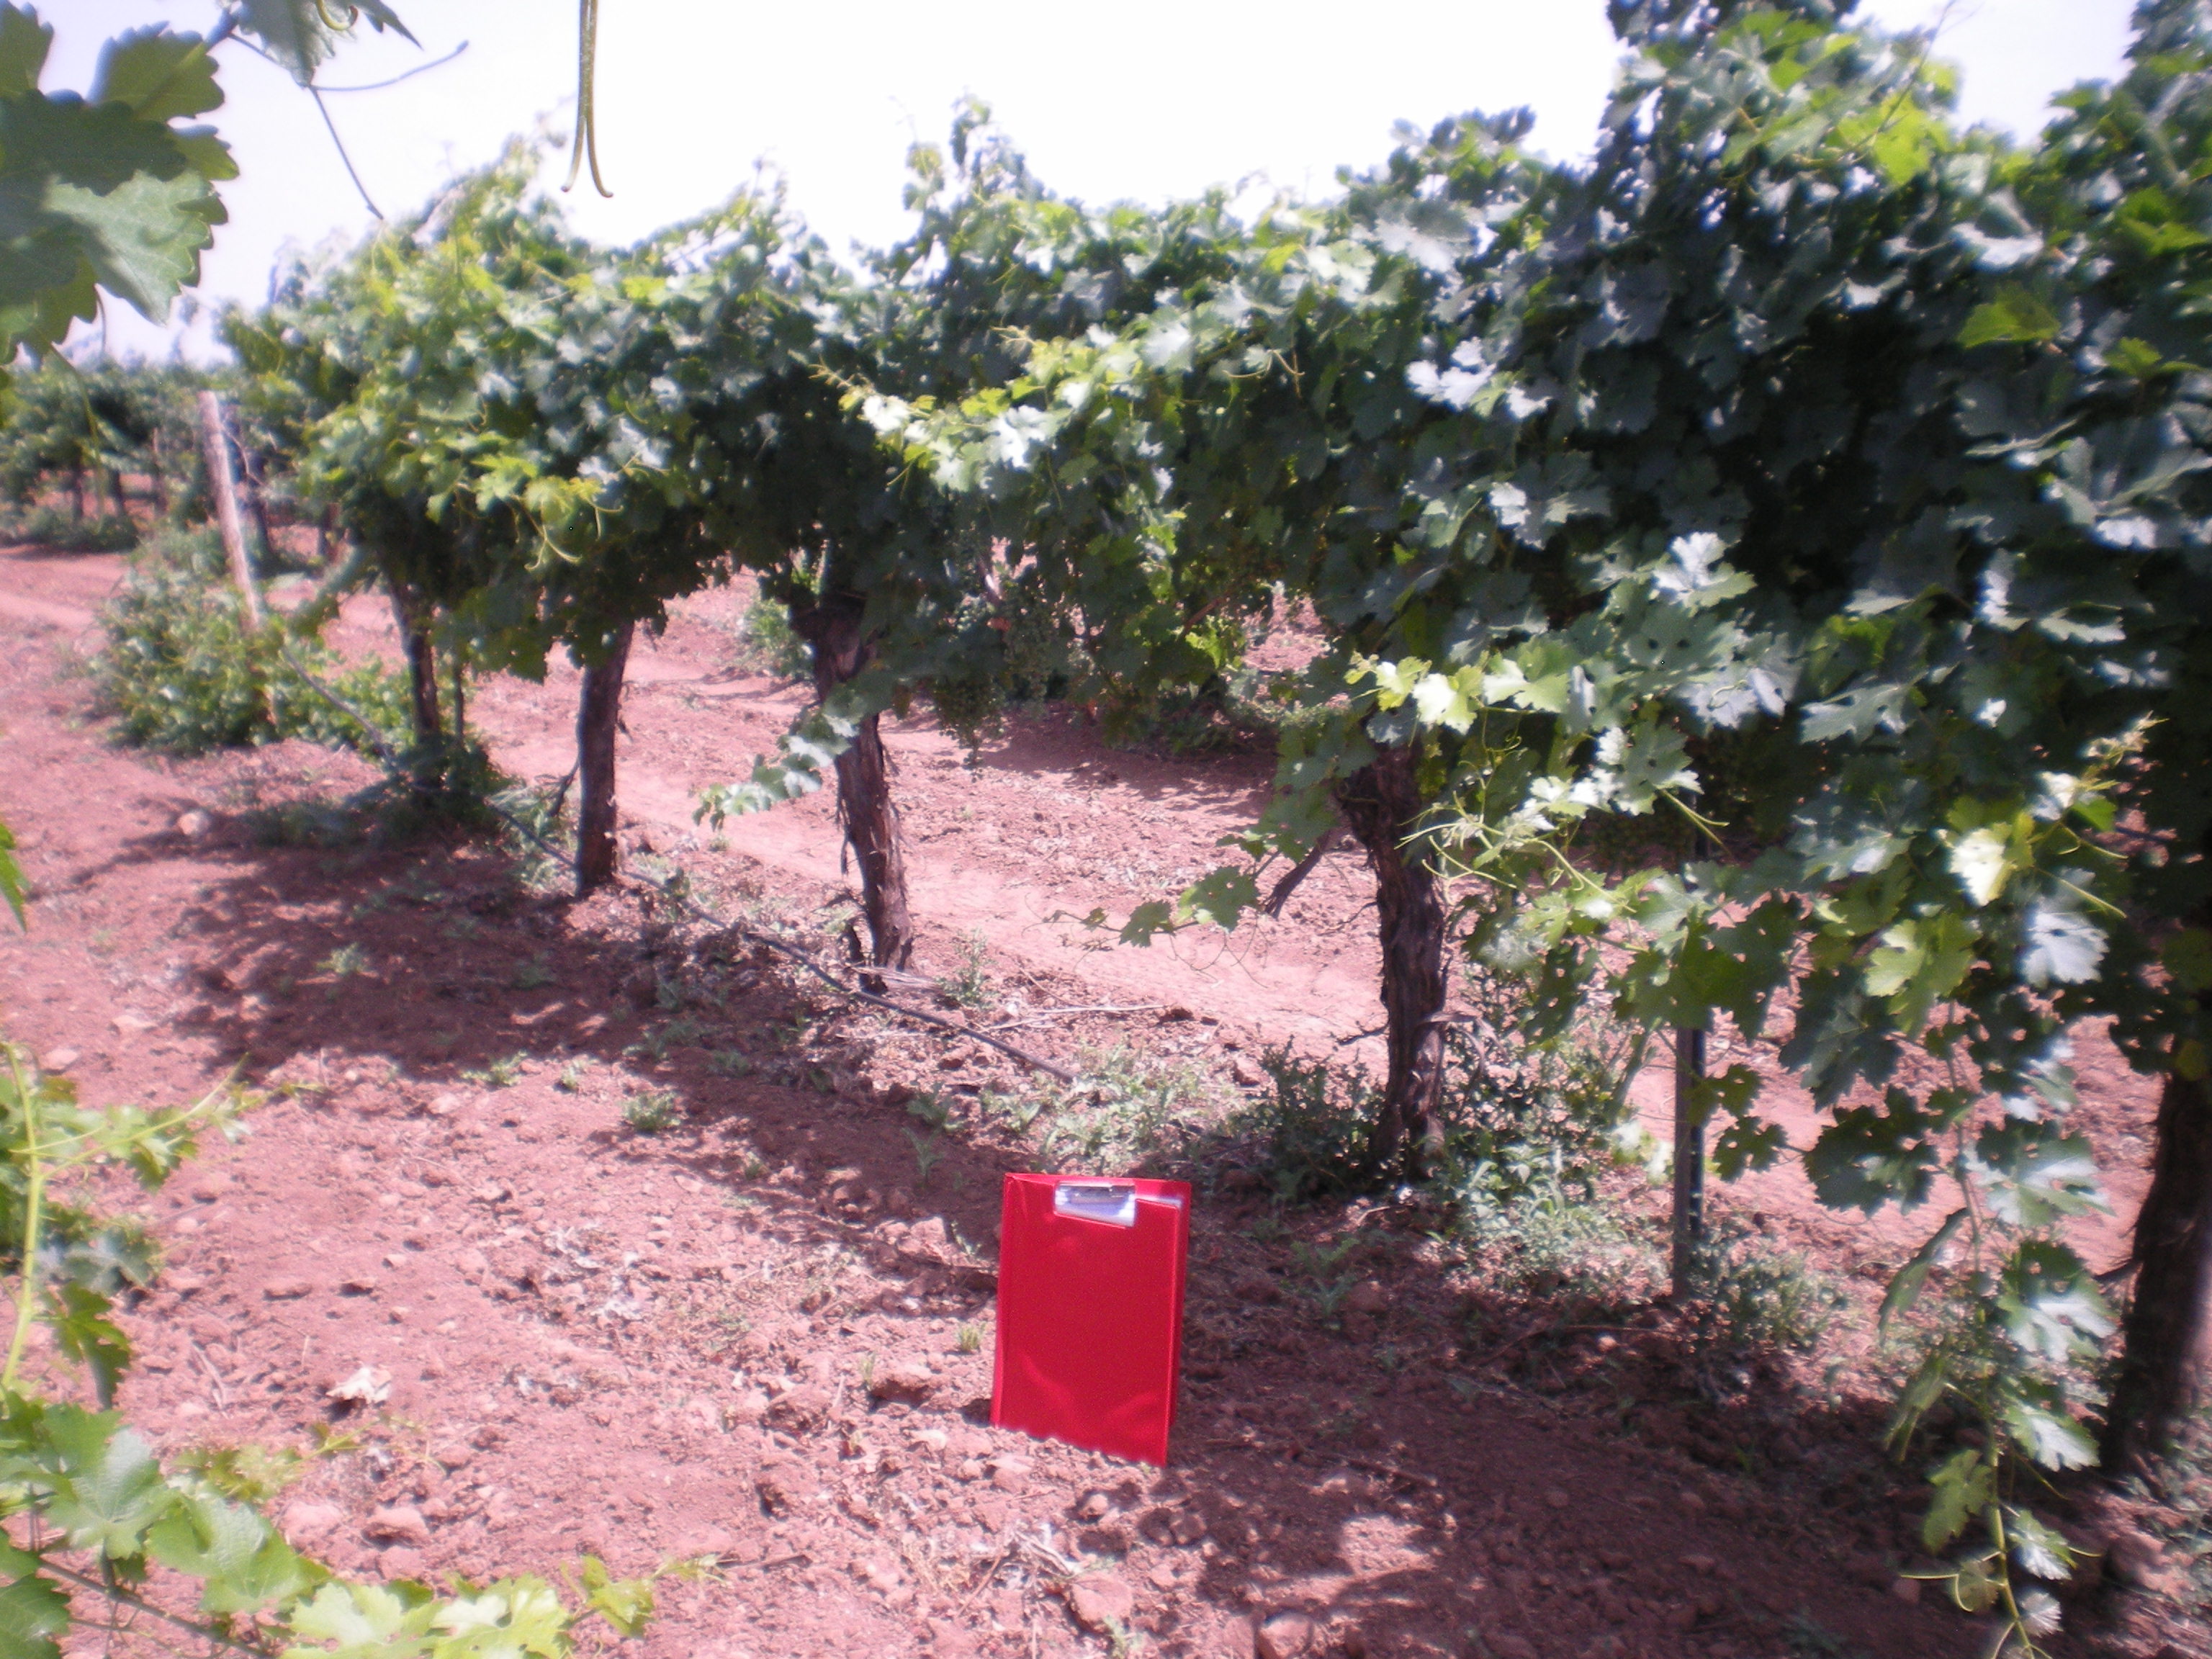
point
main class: Cropland
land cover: Vineyards
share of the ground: 10 - 25 %
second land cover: Other bare soil
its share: > 75 %
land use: Agriculture (excluding fallow land and kitchen gardens)
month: July
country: ES
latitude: 39.2506
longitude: -3.1441
